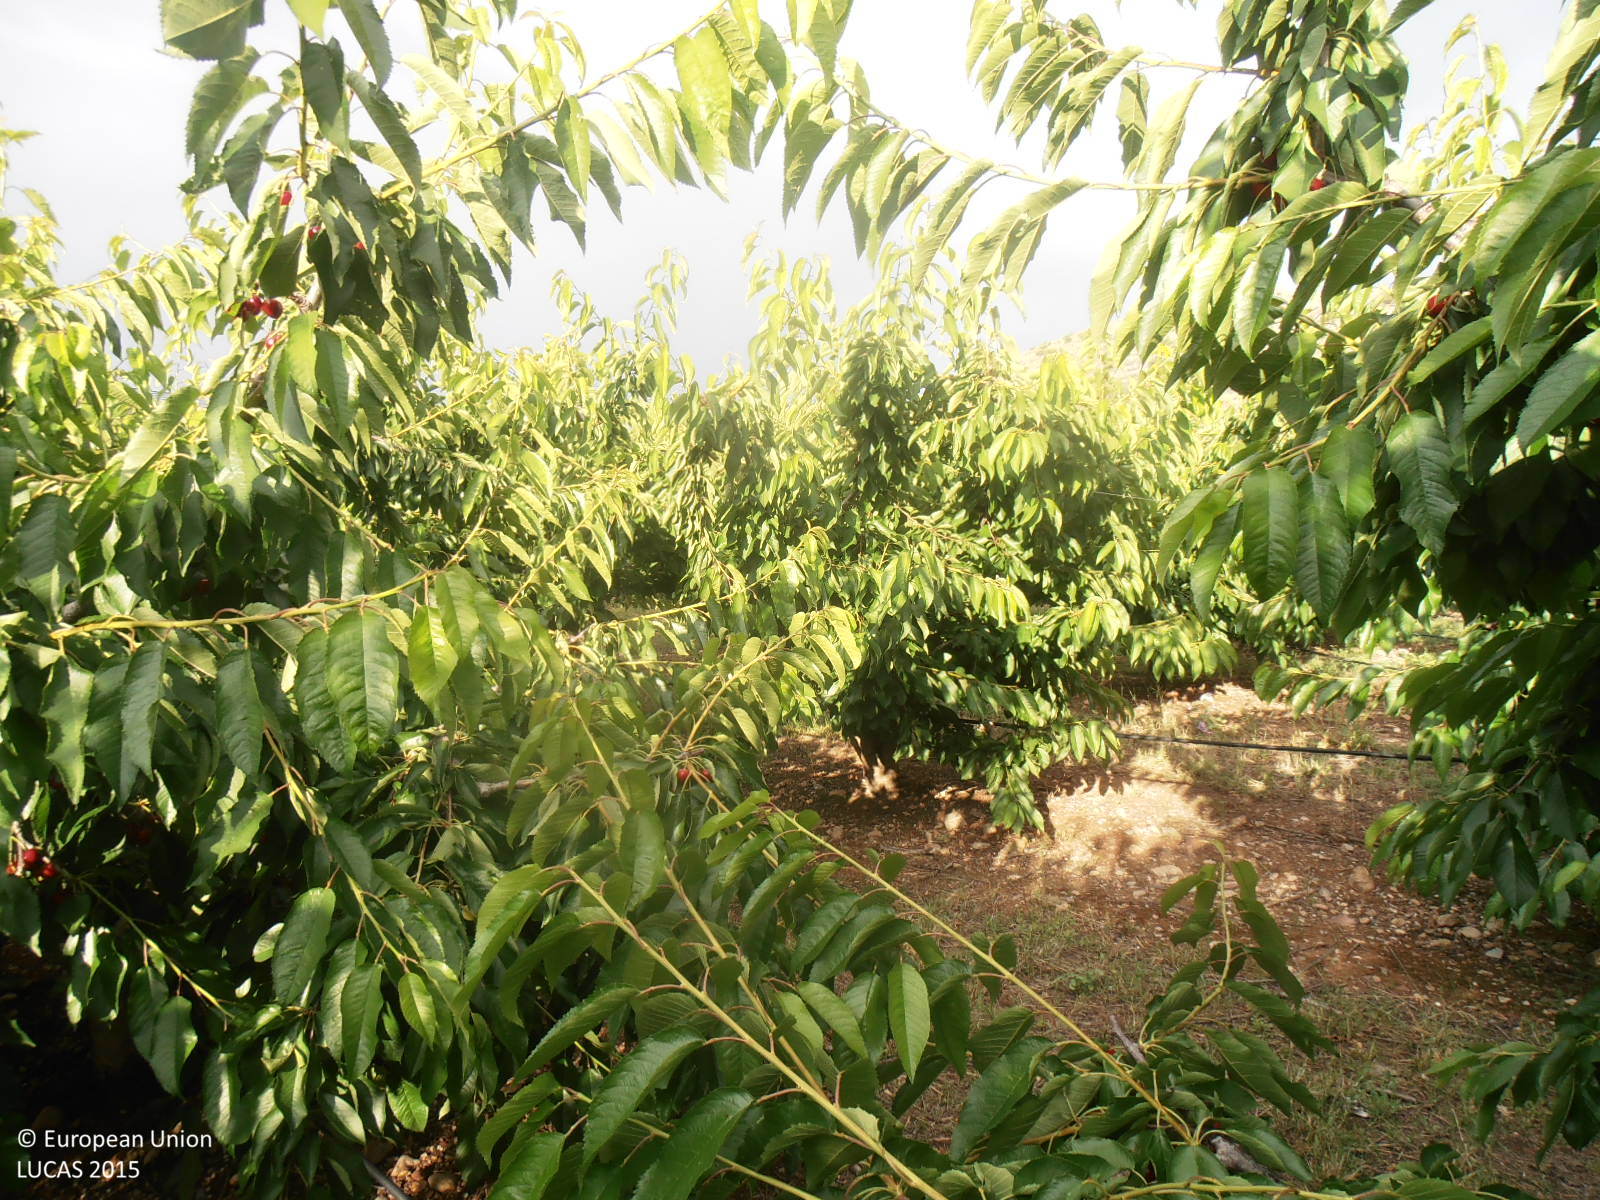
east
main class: Cropland
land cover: Cherry fruit
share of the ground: > 75 %
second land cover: Spontaneously vegetated surfaces
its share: 10 - 25 %
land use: Agriculture (excluding fallow land and kitchen gardens)
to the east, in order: Cherry fruit; Spontaneously vegetated surfaces; Tracks; Cherry fruit; Shruby margins; Inland fresh running water; Grassland without tree/shrub cover; Dry stone walls; Cherry fruit; Tracks; Olive groves; Ditches and canals; Olive groves; Shrubland without tree cover
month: June
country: ES
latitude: 41.4781
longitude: -1.4131
